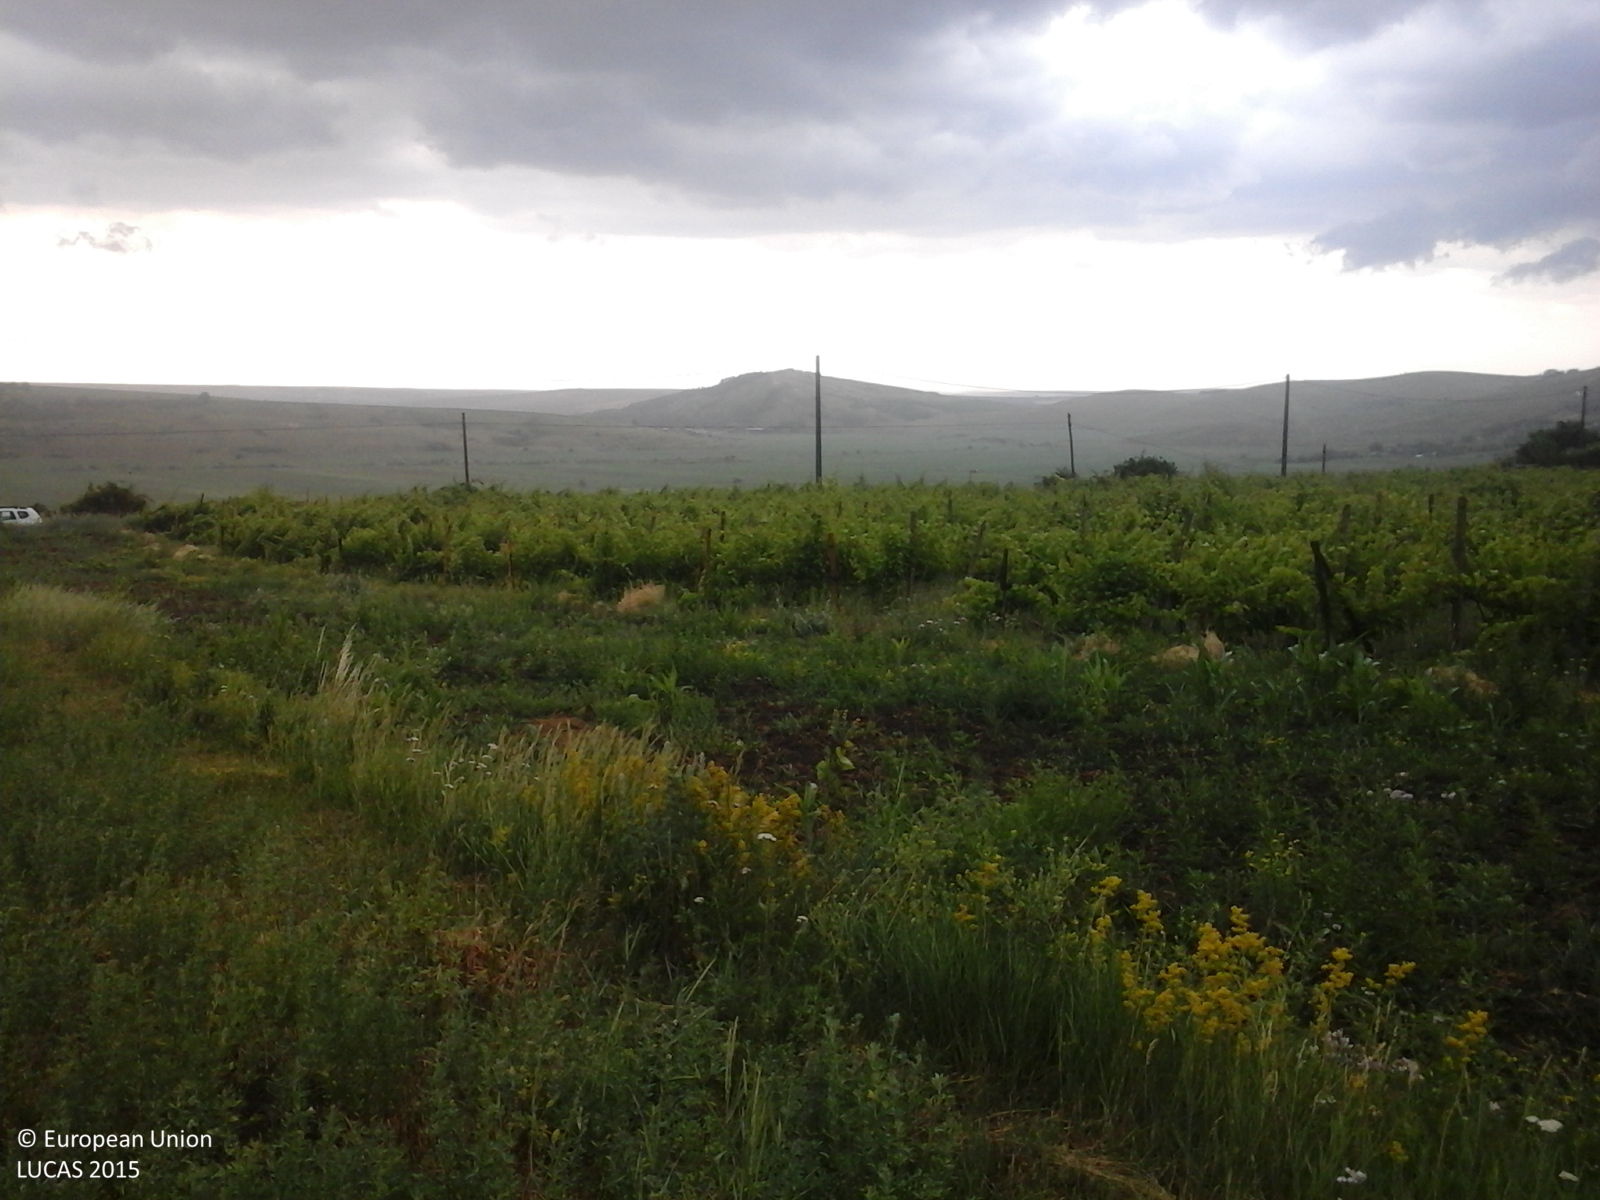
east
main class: Cropland
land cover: Lucerne
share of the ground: > 75 %
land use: Agriculture (excluding fallow land and kitchen gardens)
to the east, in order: Lucerne; Grass margins; Vineyards; Electric lines; Grass margins; Paved roads, cycling and walking lanes; Grass margins; Electric lines; Vineyards; Tracks; Maize; Lucerne; Grass margins
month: June
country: RO
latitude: 47.3261
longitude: 26.9170
